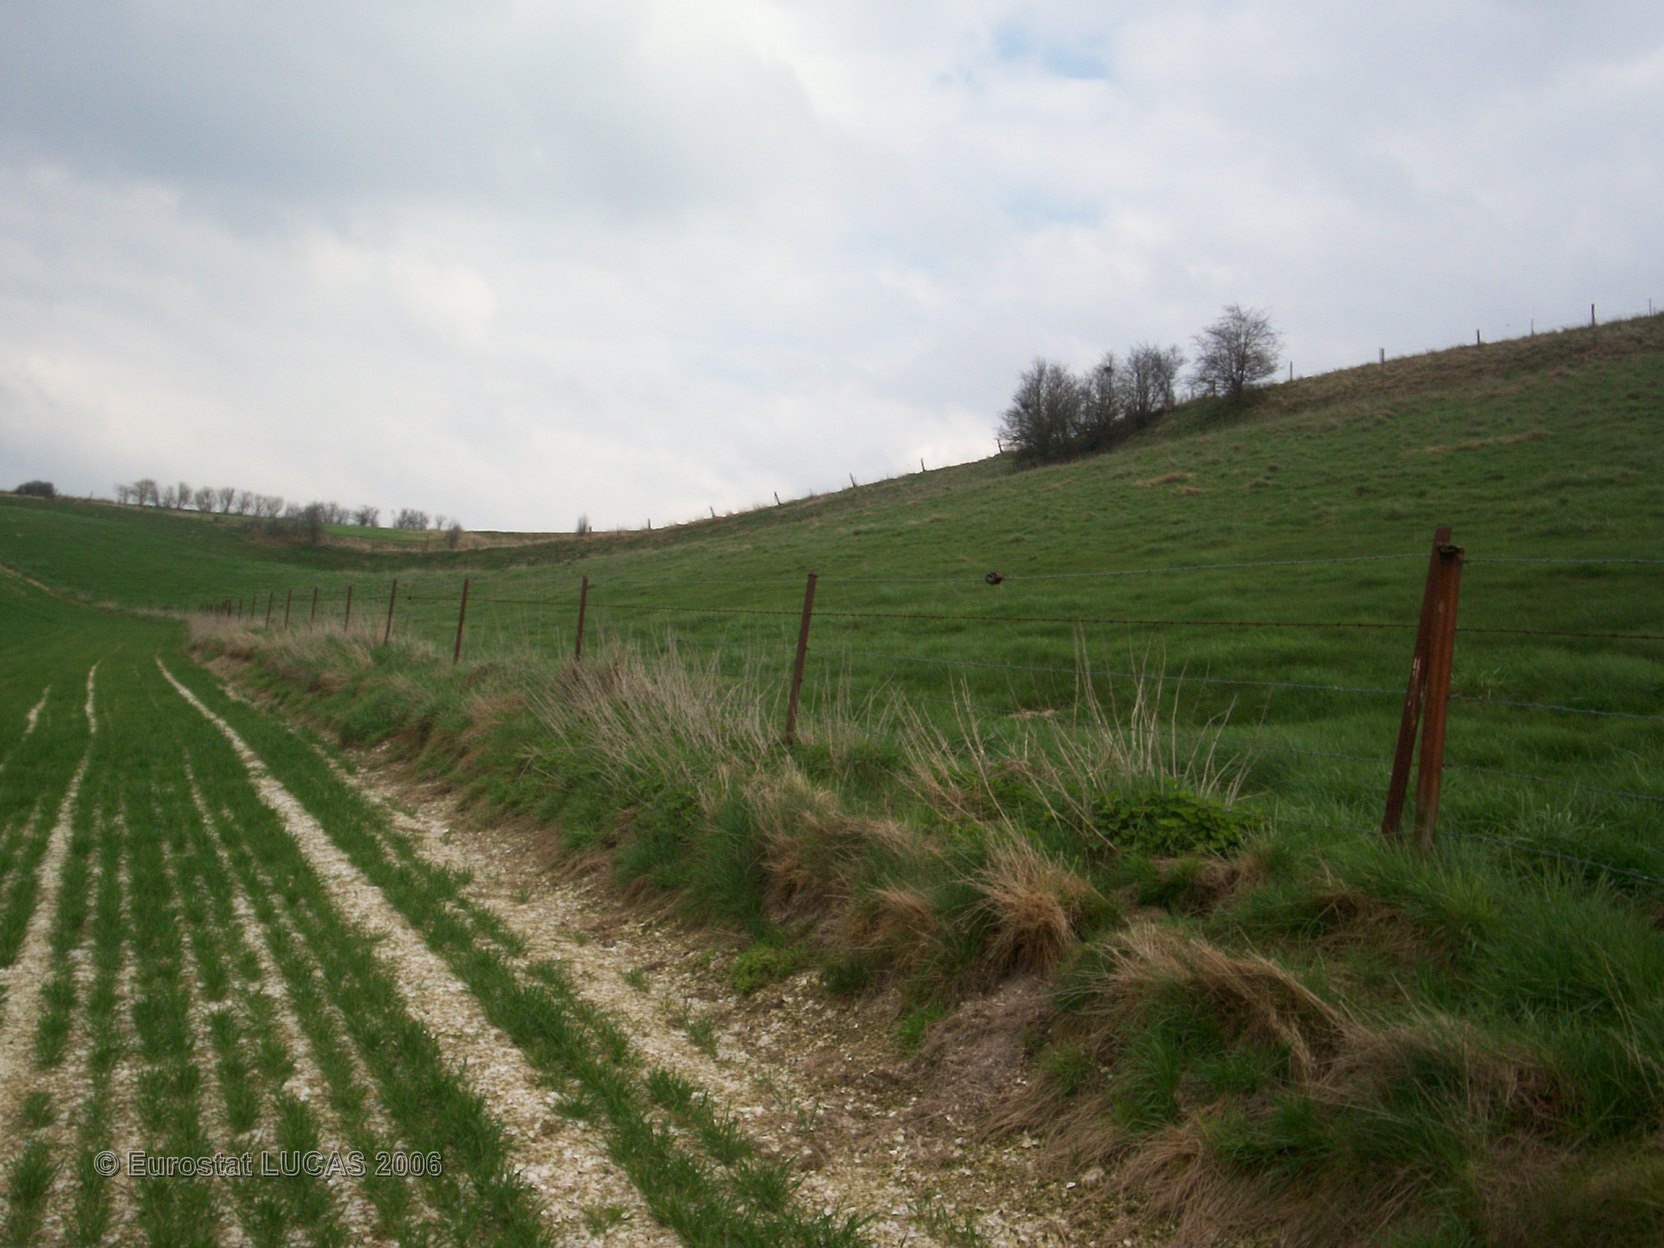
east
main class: Cropland
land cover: Common wheat
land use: Agriculture (excluding fallow land and kitchen gardens)
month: April
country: FR
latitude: 50.0286
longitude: 2.5194
